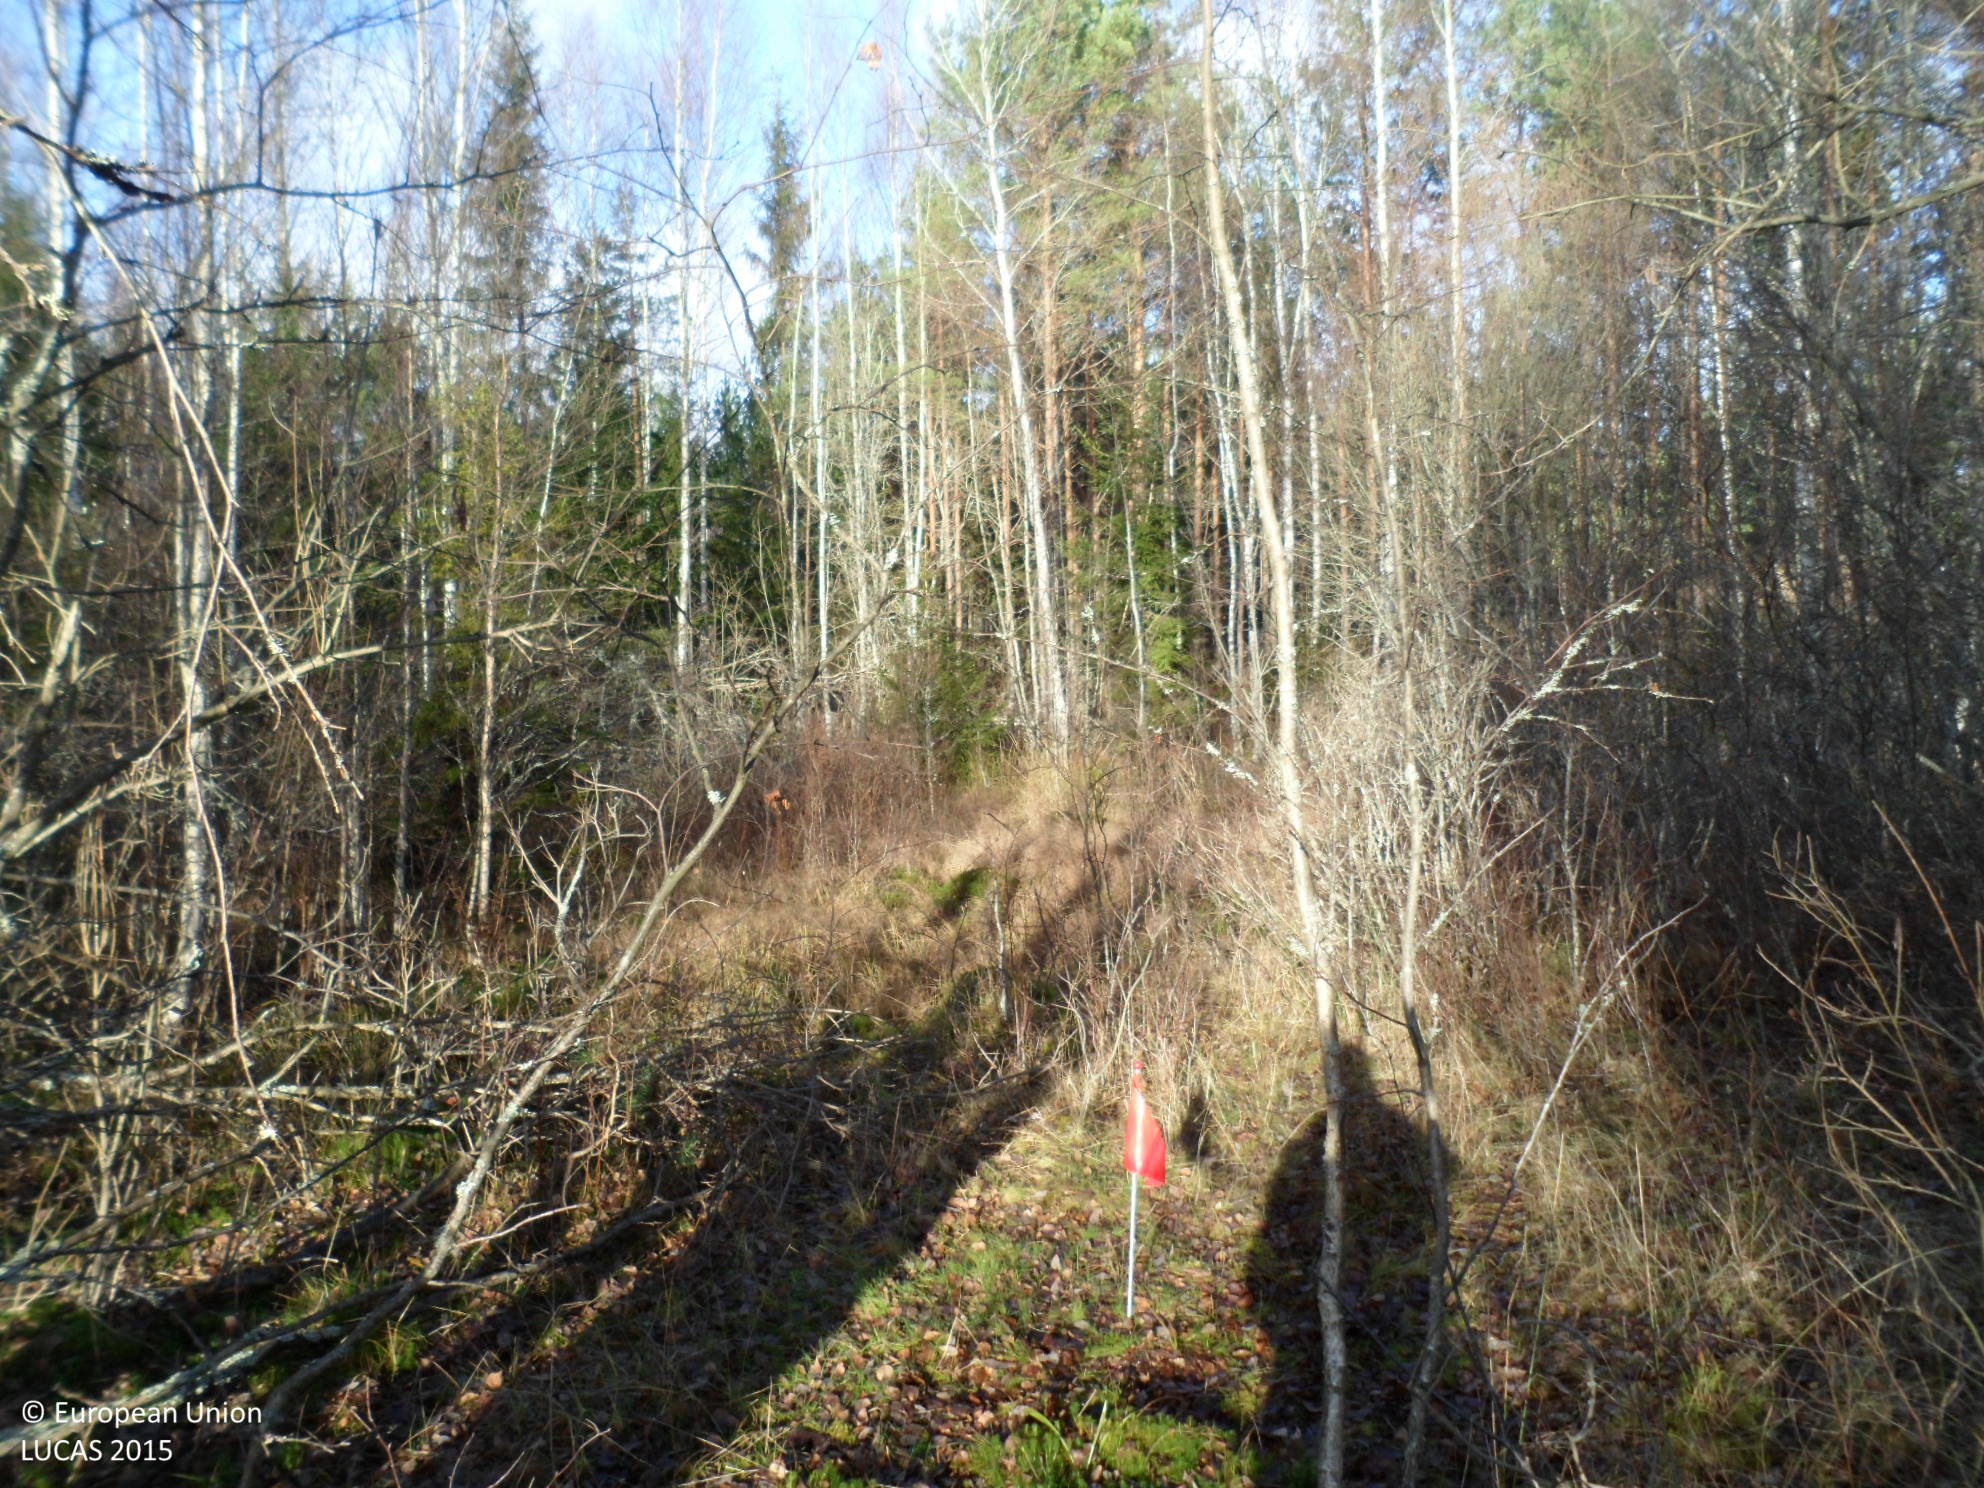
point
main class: Woodland
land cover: Broadleaved woodland
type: boreal forest
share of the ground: 50 - 75 %
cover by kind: broadleaved forest trees 50 %, shrubs 25 %, herbaceous plants 10 %, lichens and mosses 10 %, coniferous forest trees 5 %
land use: Forestry
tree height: > 5 m
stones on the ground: < 10 %
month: November
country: SE
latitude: 57.2310
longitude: 16.1447
